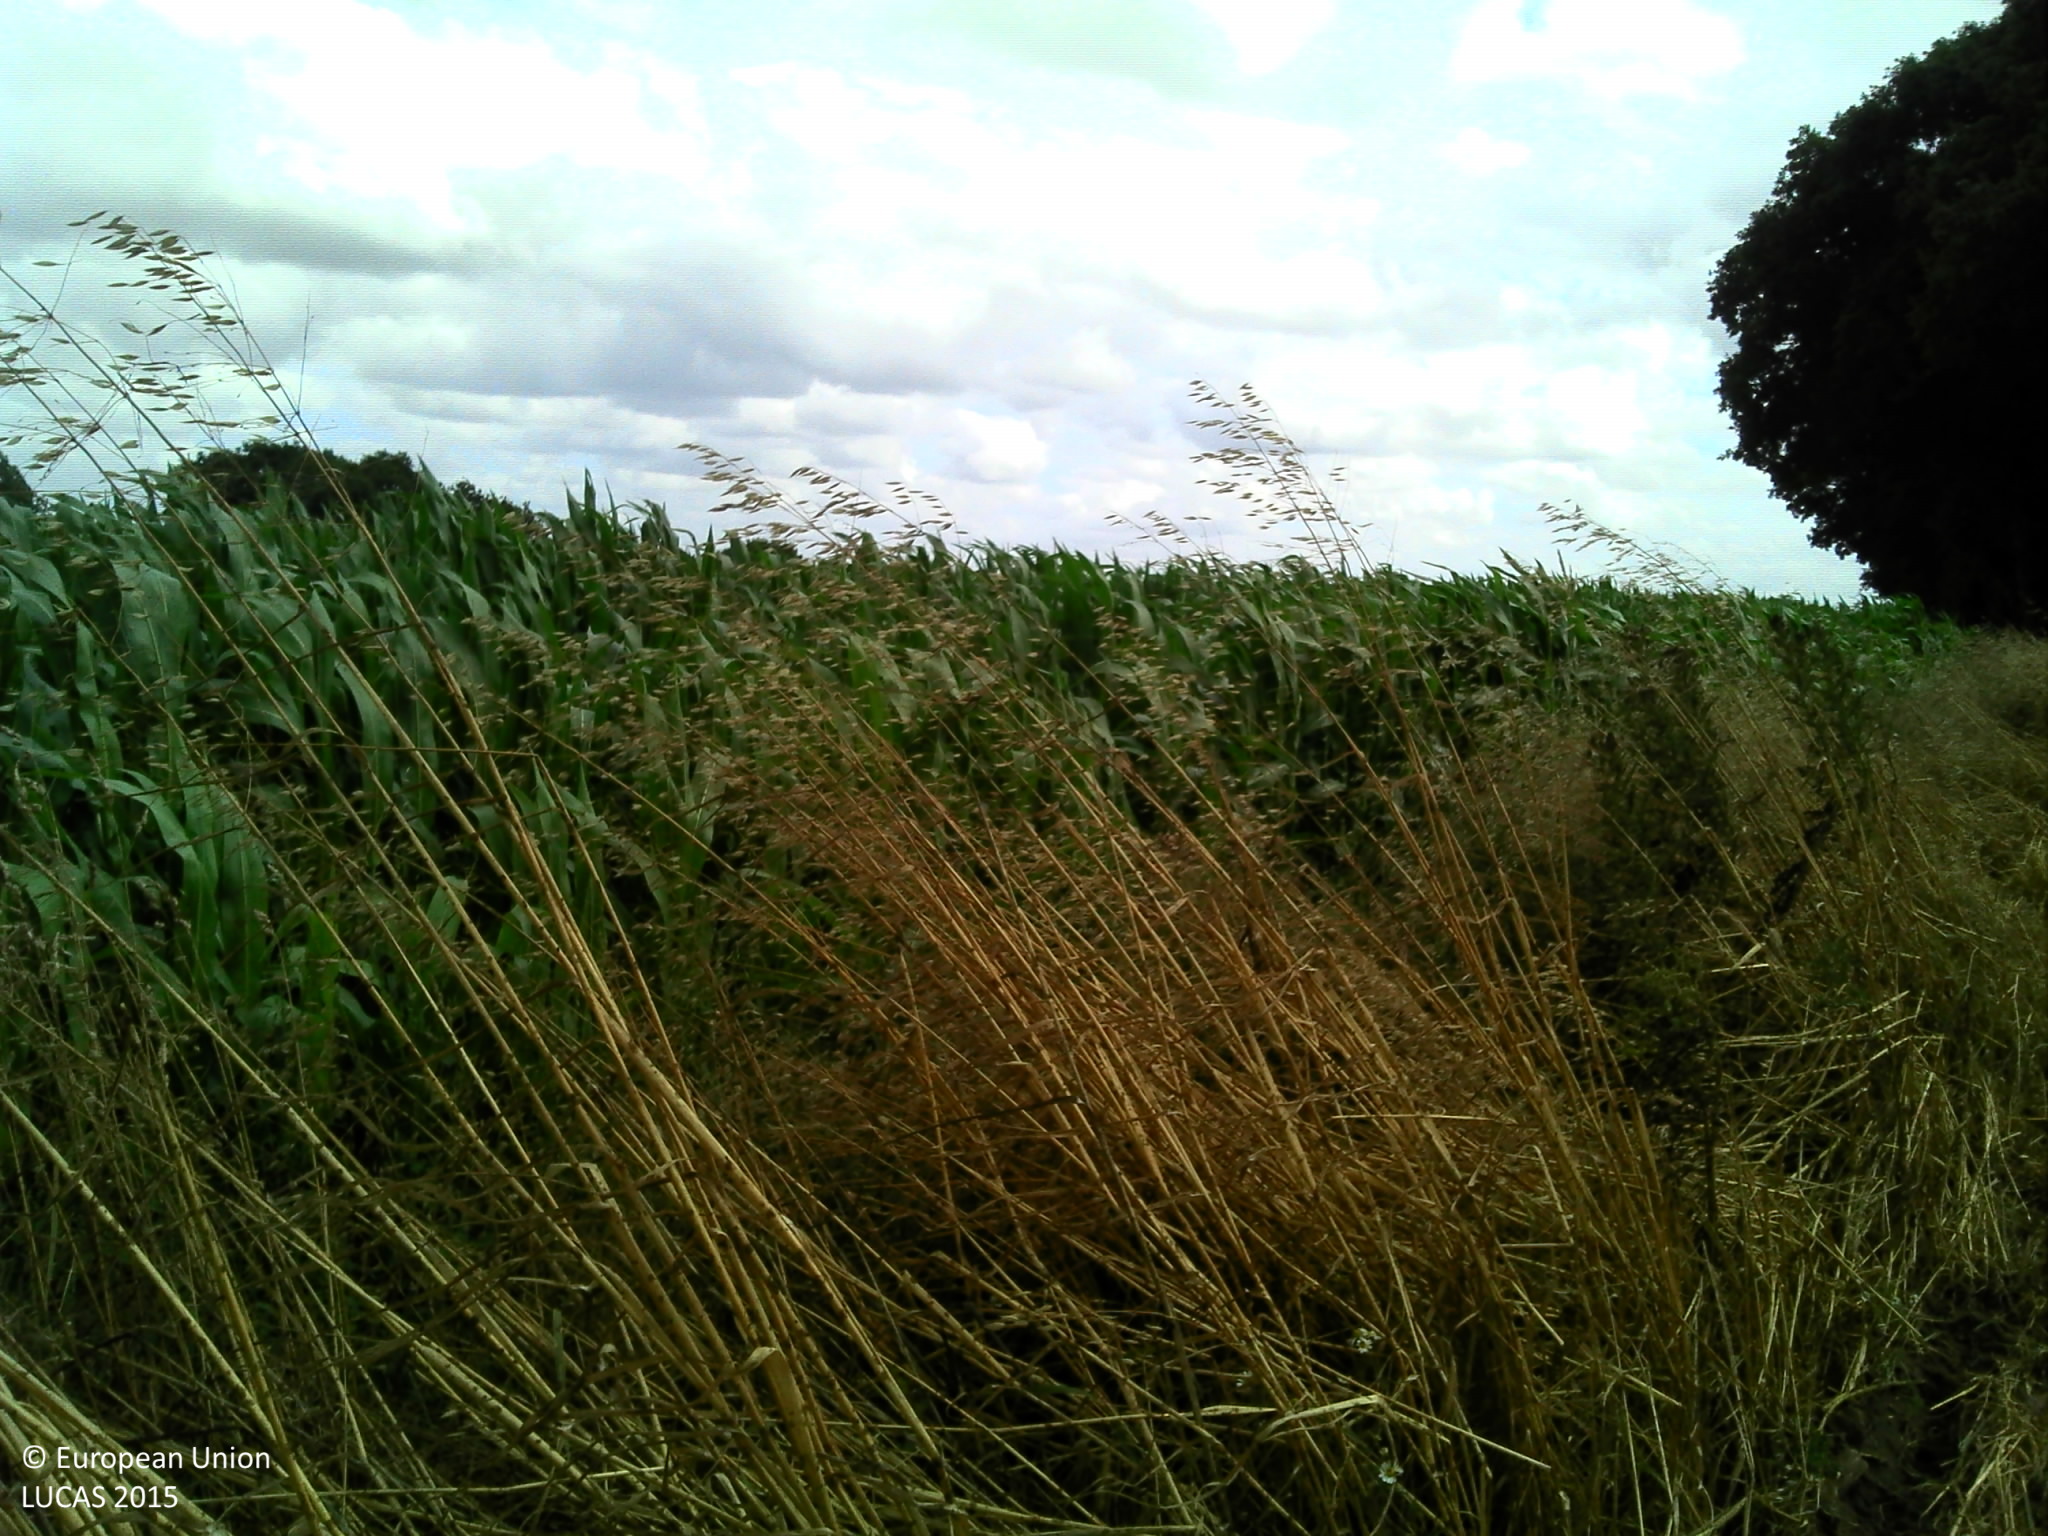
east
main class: Cropland
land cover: Maize
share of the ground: > 75 %
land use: Agriculture (excluding fallow land and kitchen gardens)
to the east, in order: Maize; Grass margins; Electric lines; Ditches and canals; Grass margins; Paved roads, cycling and walking lanes; Grass margins; Ditches and canals; Grass margins; Maize
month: August
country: FR
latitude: 48.2954
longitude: -3.2429
